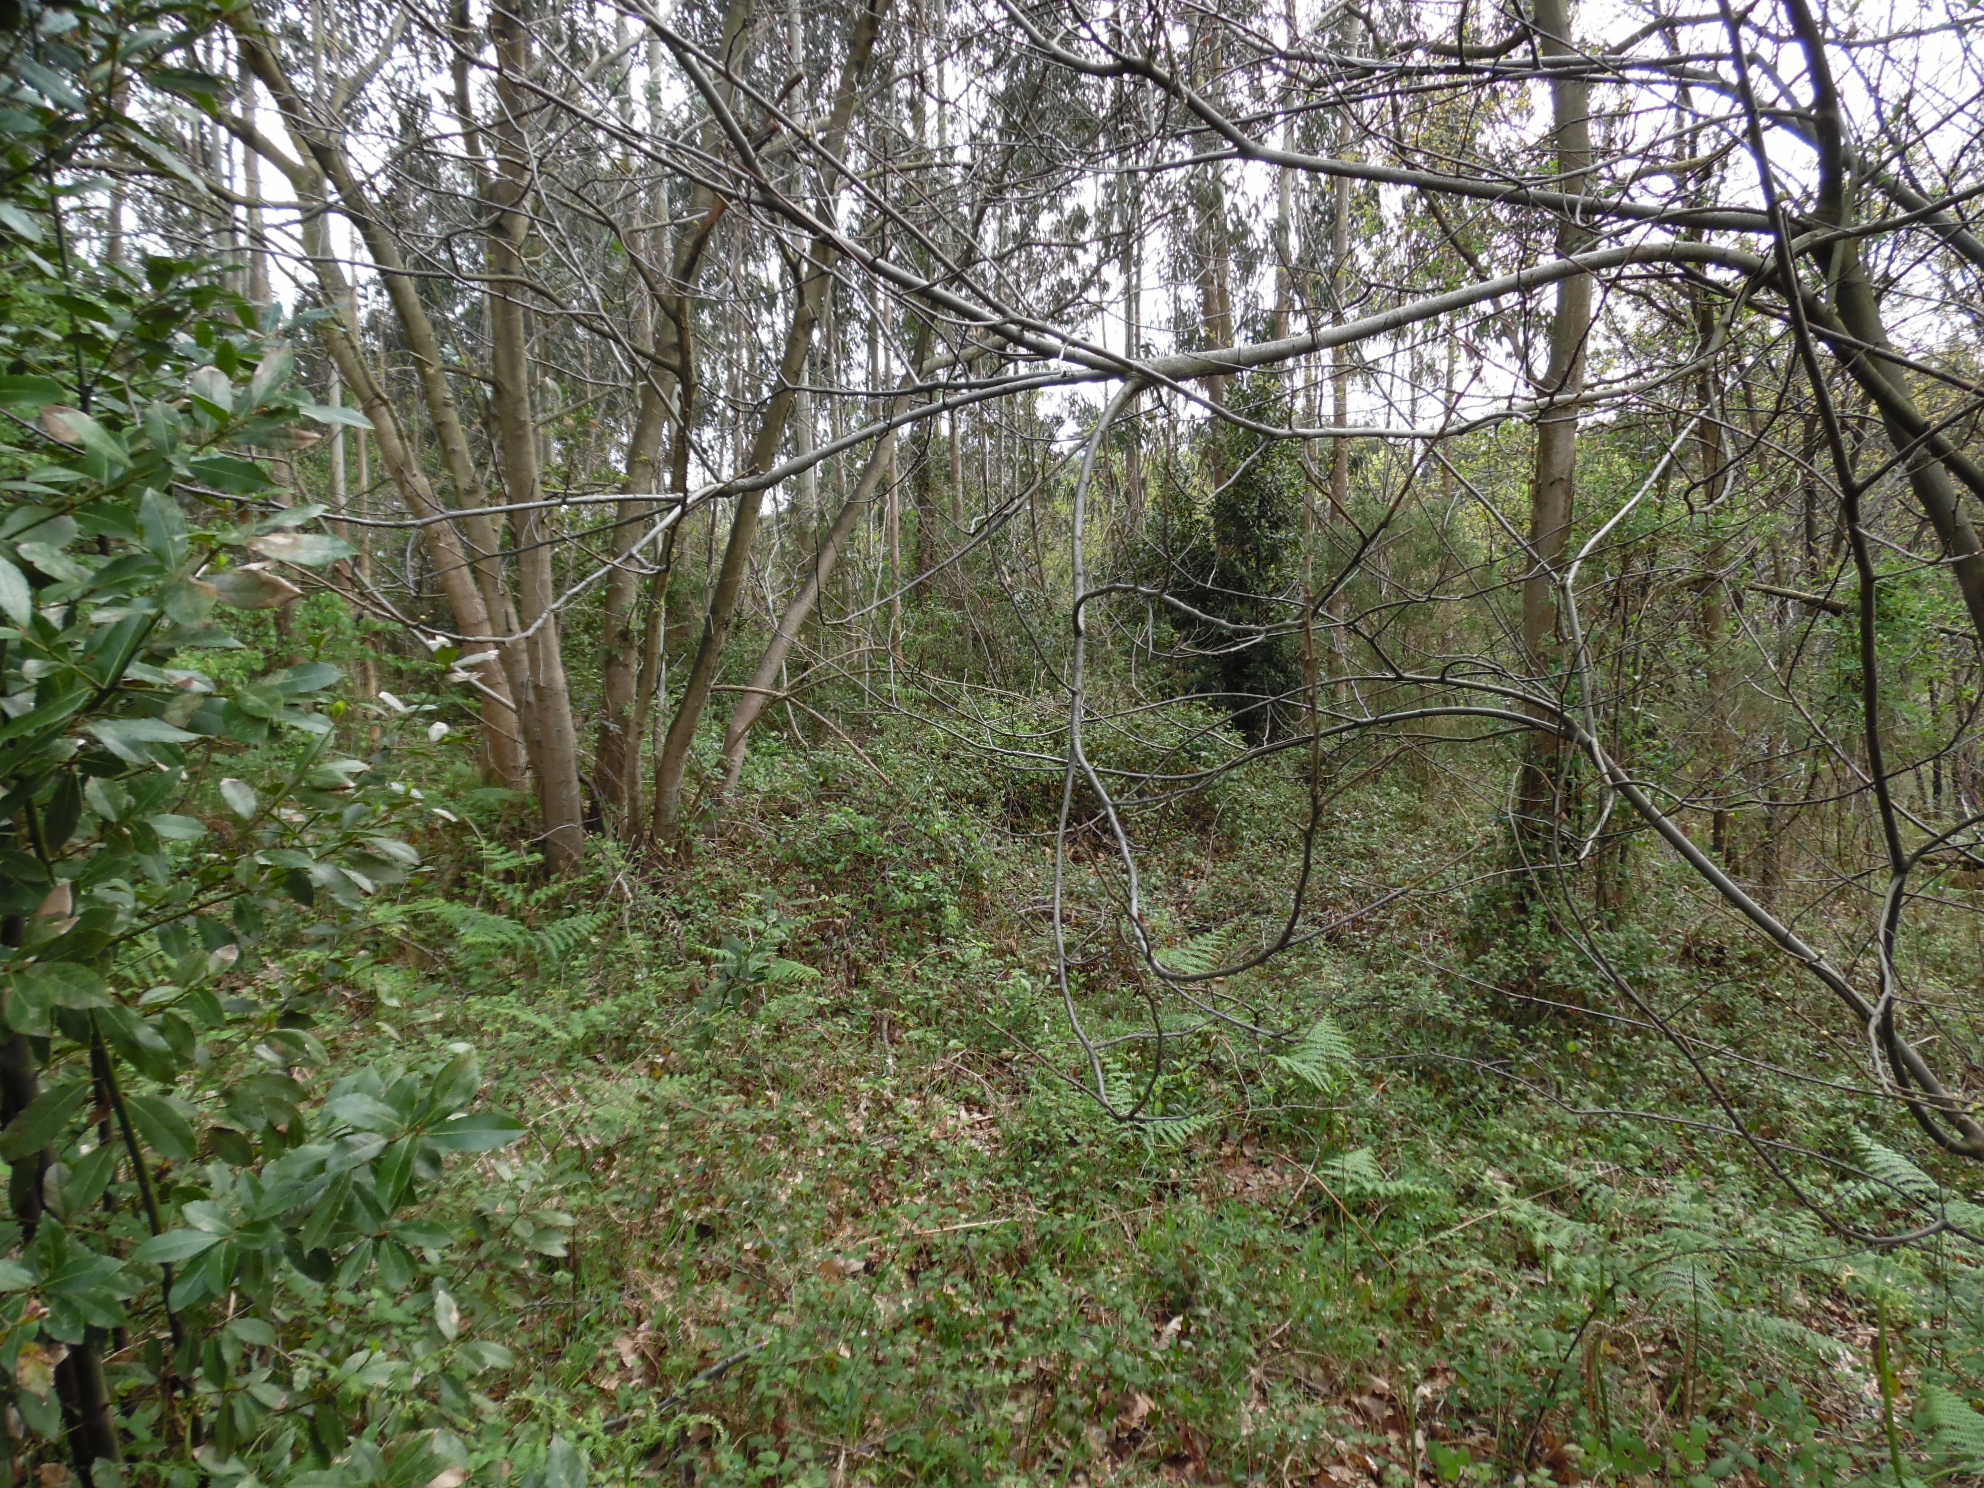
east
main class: Woodland
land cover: Broadleaved woodland
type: exotic forest
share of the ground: > 75 %
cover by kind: broadleaved forest trees 95 %, shrubs 5 %
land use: Forestry
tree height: > 5 m
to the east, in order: Broadleaved woodland; Electric lines; Broadleaved woodland; Grass margins; Tracks; Grass margins; Electric lines; Shrubland without tree cover; Broadleaved woodland
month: April
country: ES
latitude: 43.5597
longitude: -5.8746
